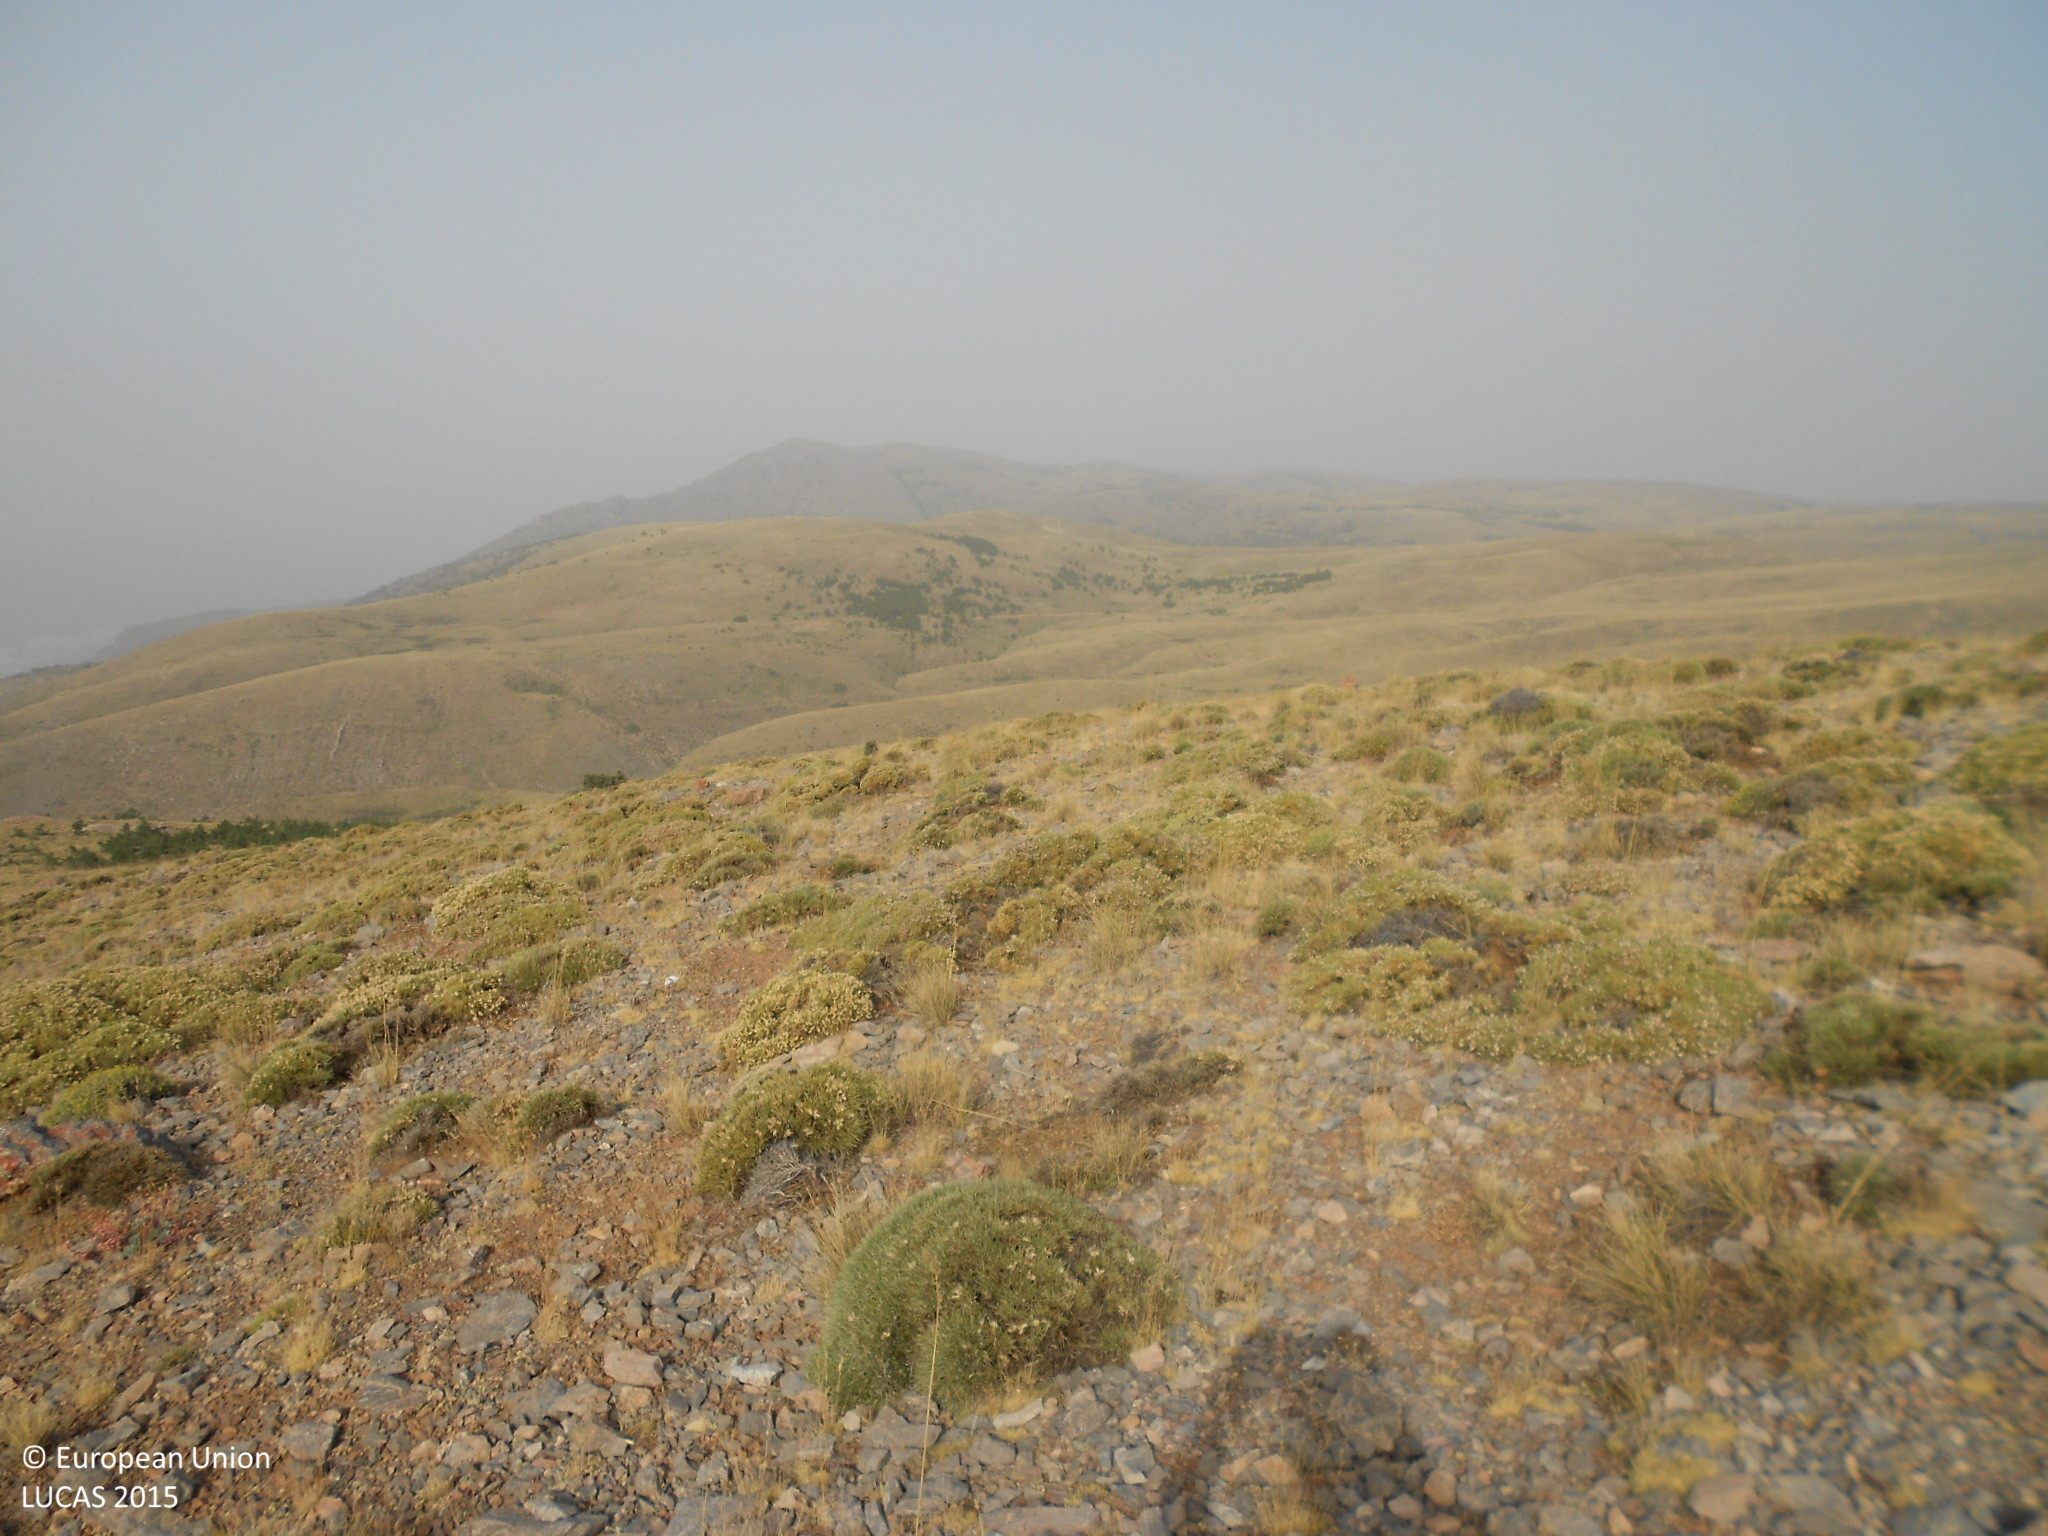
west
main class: Shrubland
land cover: Shrubland without tree cover
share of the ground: > 75 %
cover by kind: herbaceous plants 55 %, shrubs 25 %, consolidated bare surface 10 %, unconsolidated bare surface 10 %
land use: Semi-natural and natural areas not in use
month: August
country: ES
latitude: 36.8785
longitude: -2.8015
